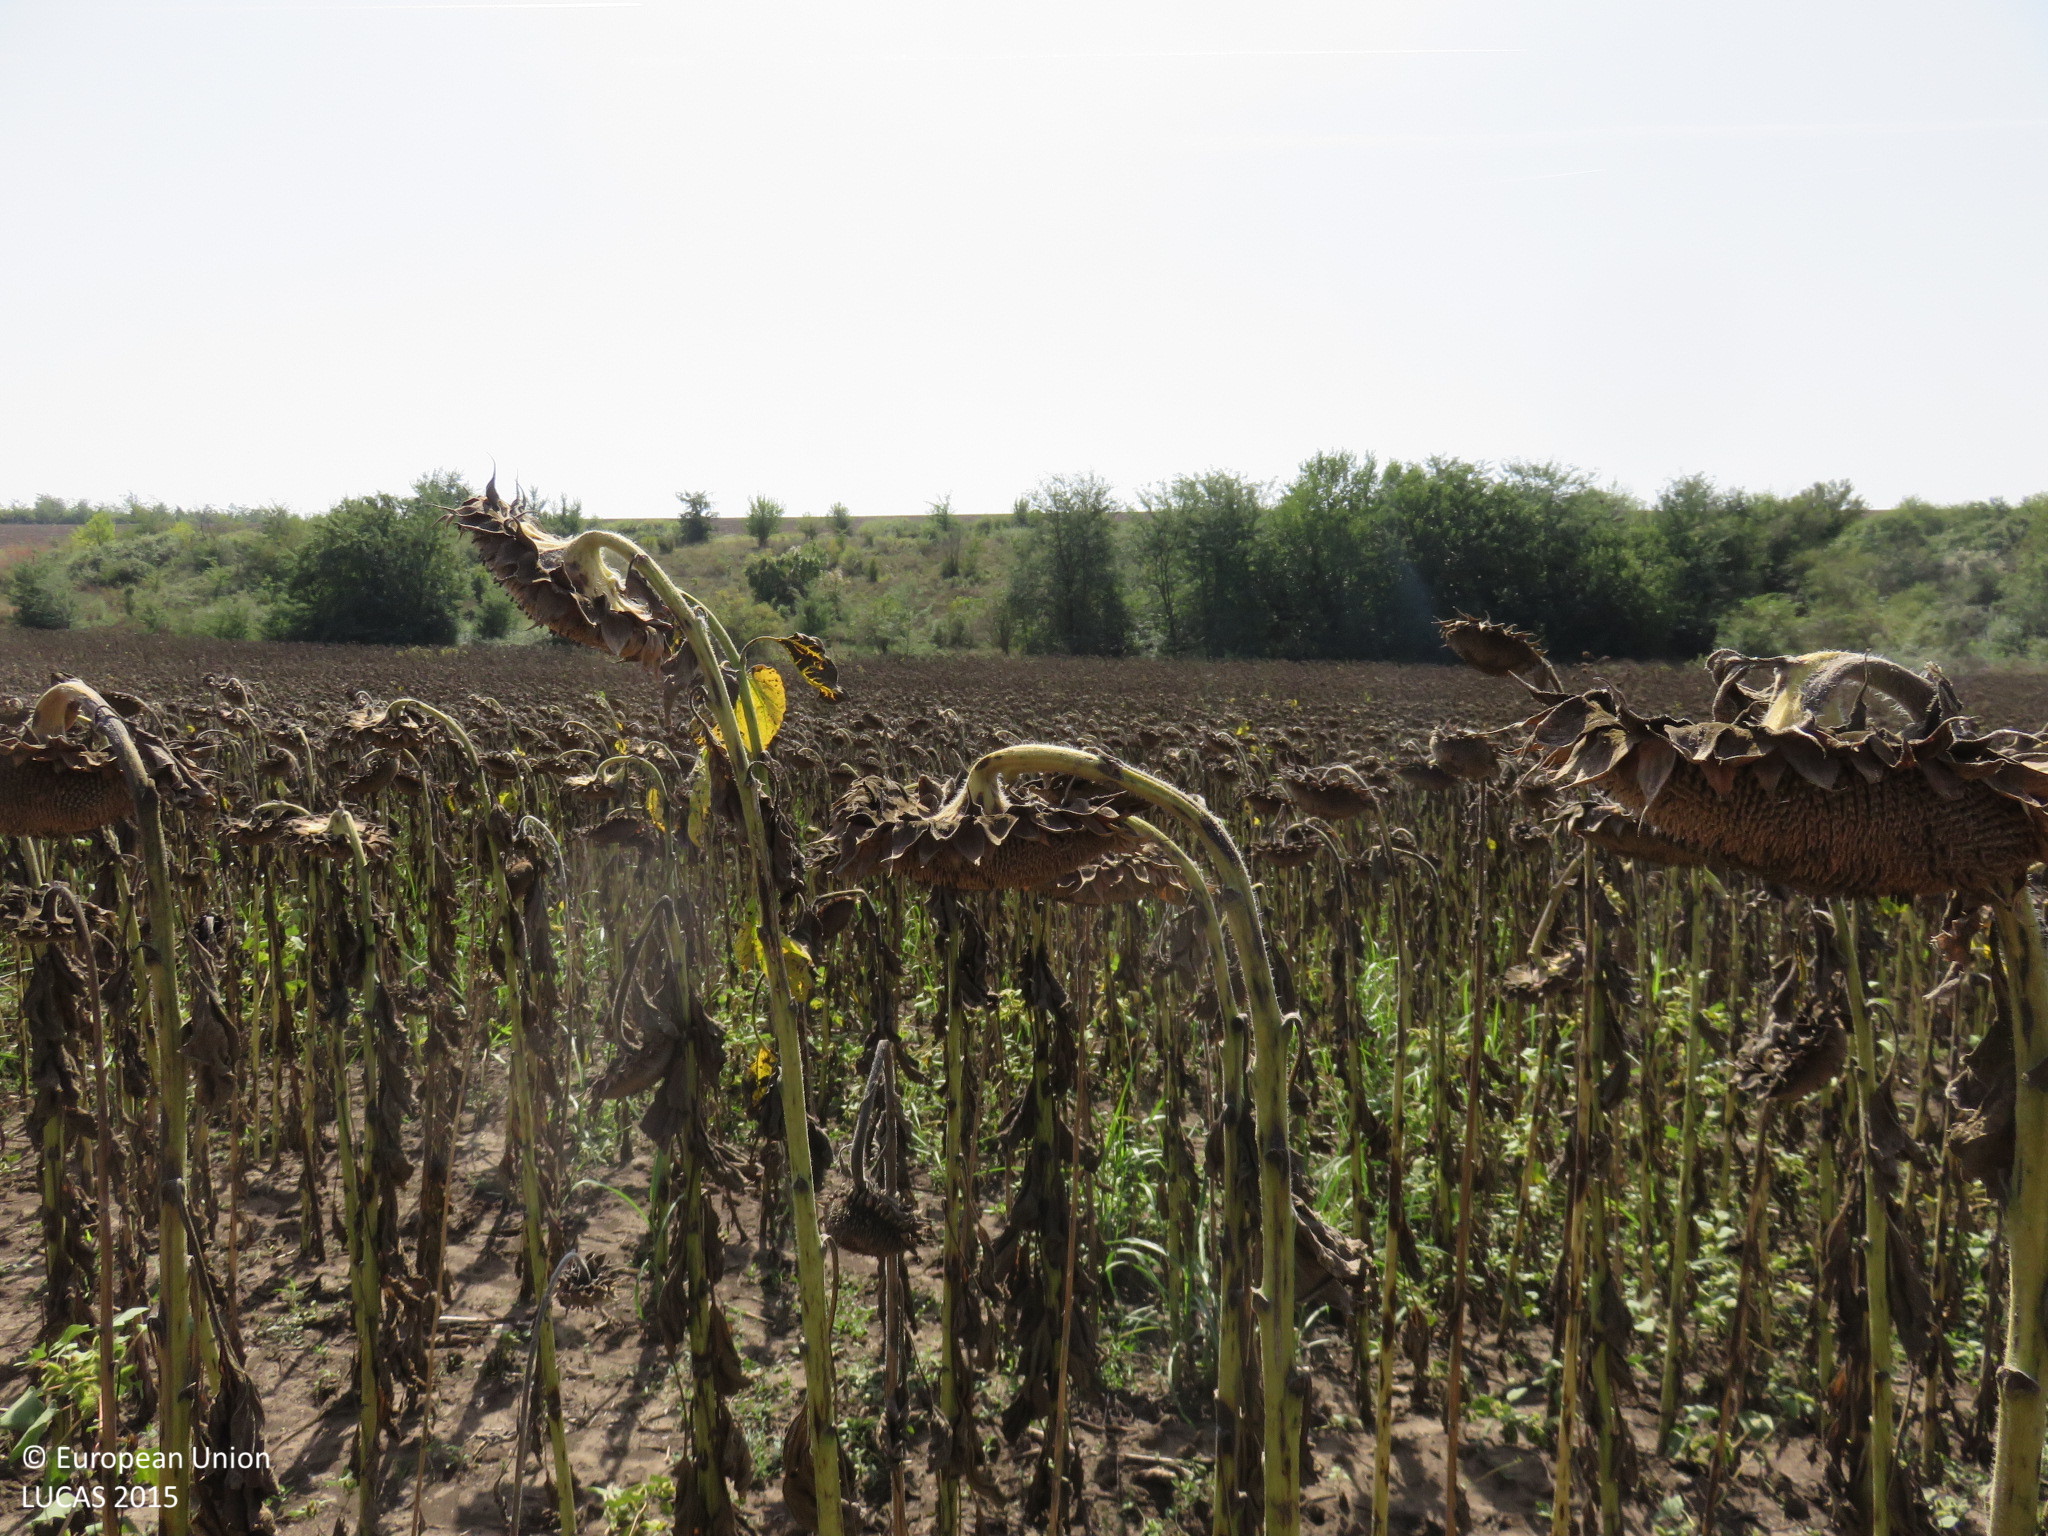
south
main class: Cropland
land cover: Sunflower
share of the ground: > 75 %
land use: Agriculture (excluding fallow land and kitchen gardens)
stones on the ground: < 10 %
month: September
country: BG
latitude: 43.5588
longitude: 24.5345
